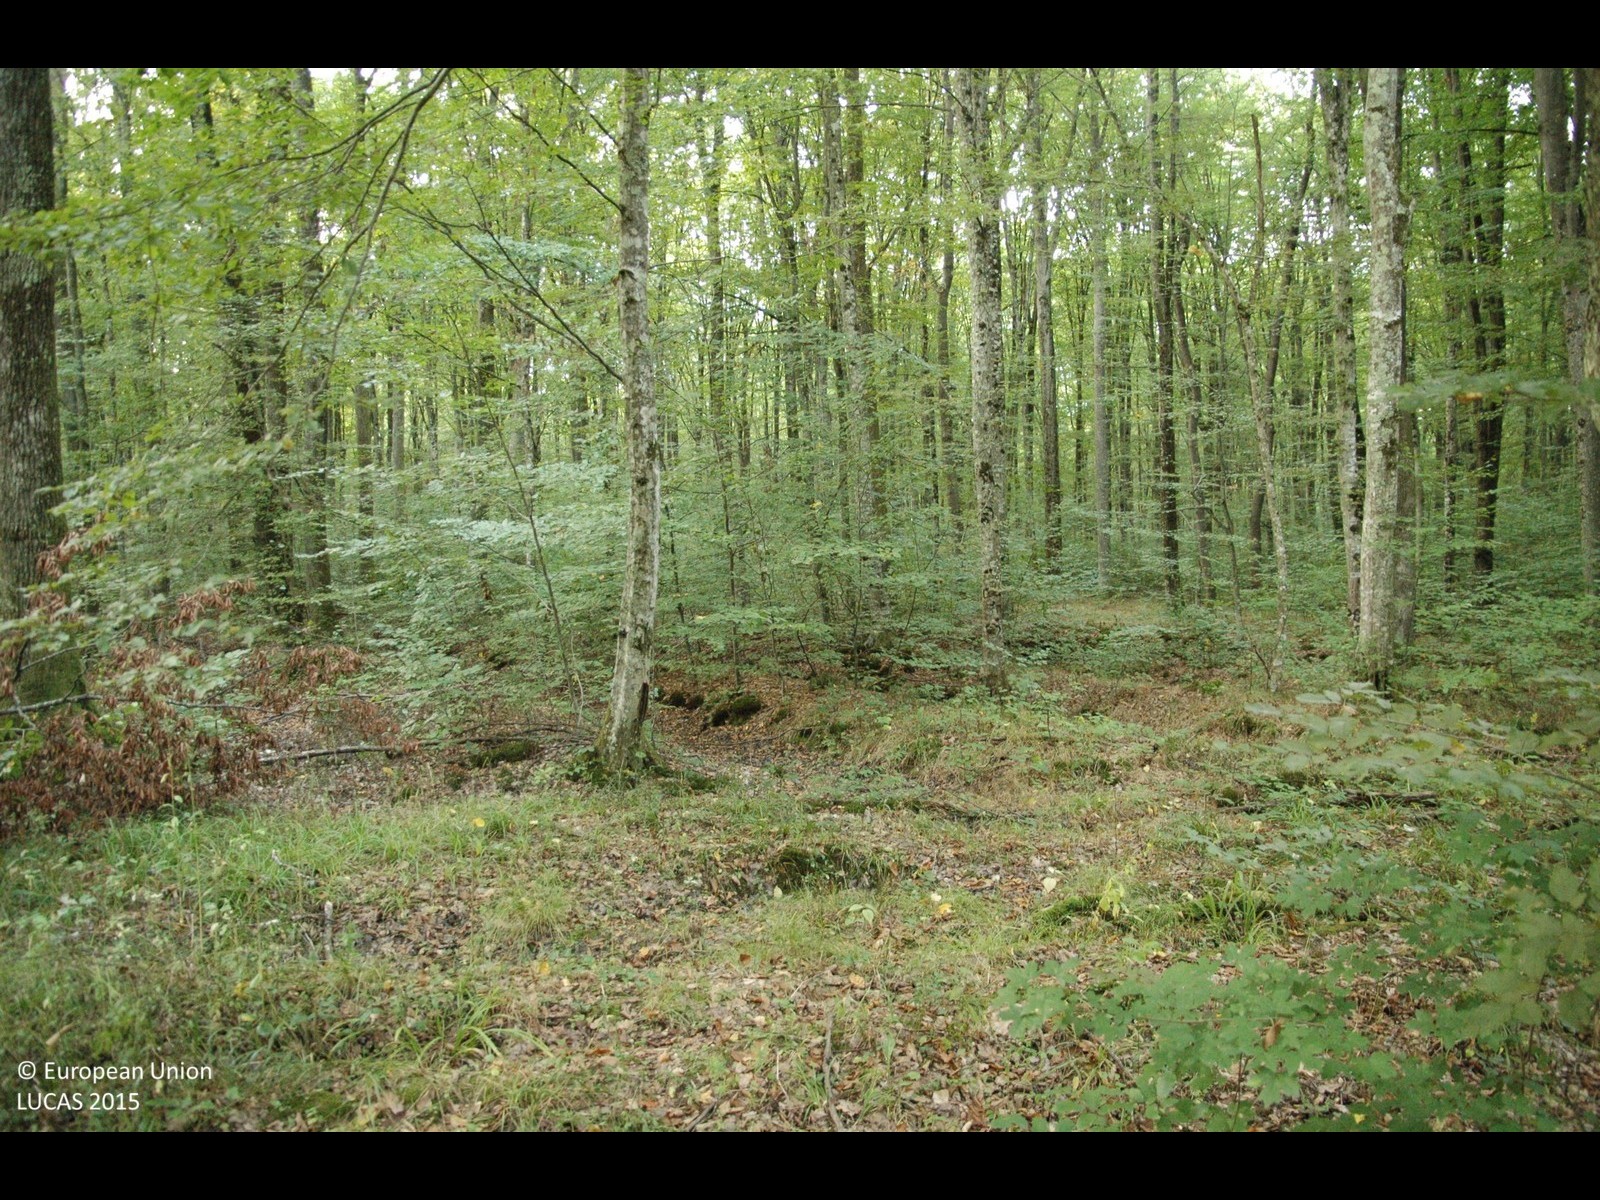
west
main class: Woodland
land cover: Broadleaved woodland
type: mesophytic deciduous forest
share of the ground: > 75 %
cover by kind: broadleaved forest trees 100 %
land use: Forestry
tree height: > 5 m
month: October
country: HR
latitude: 45.5385
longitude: 16.2087
